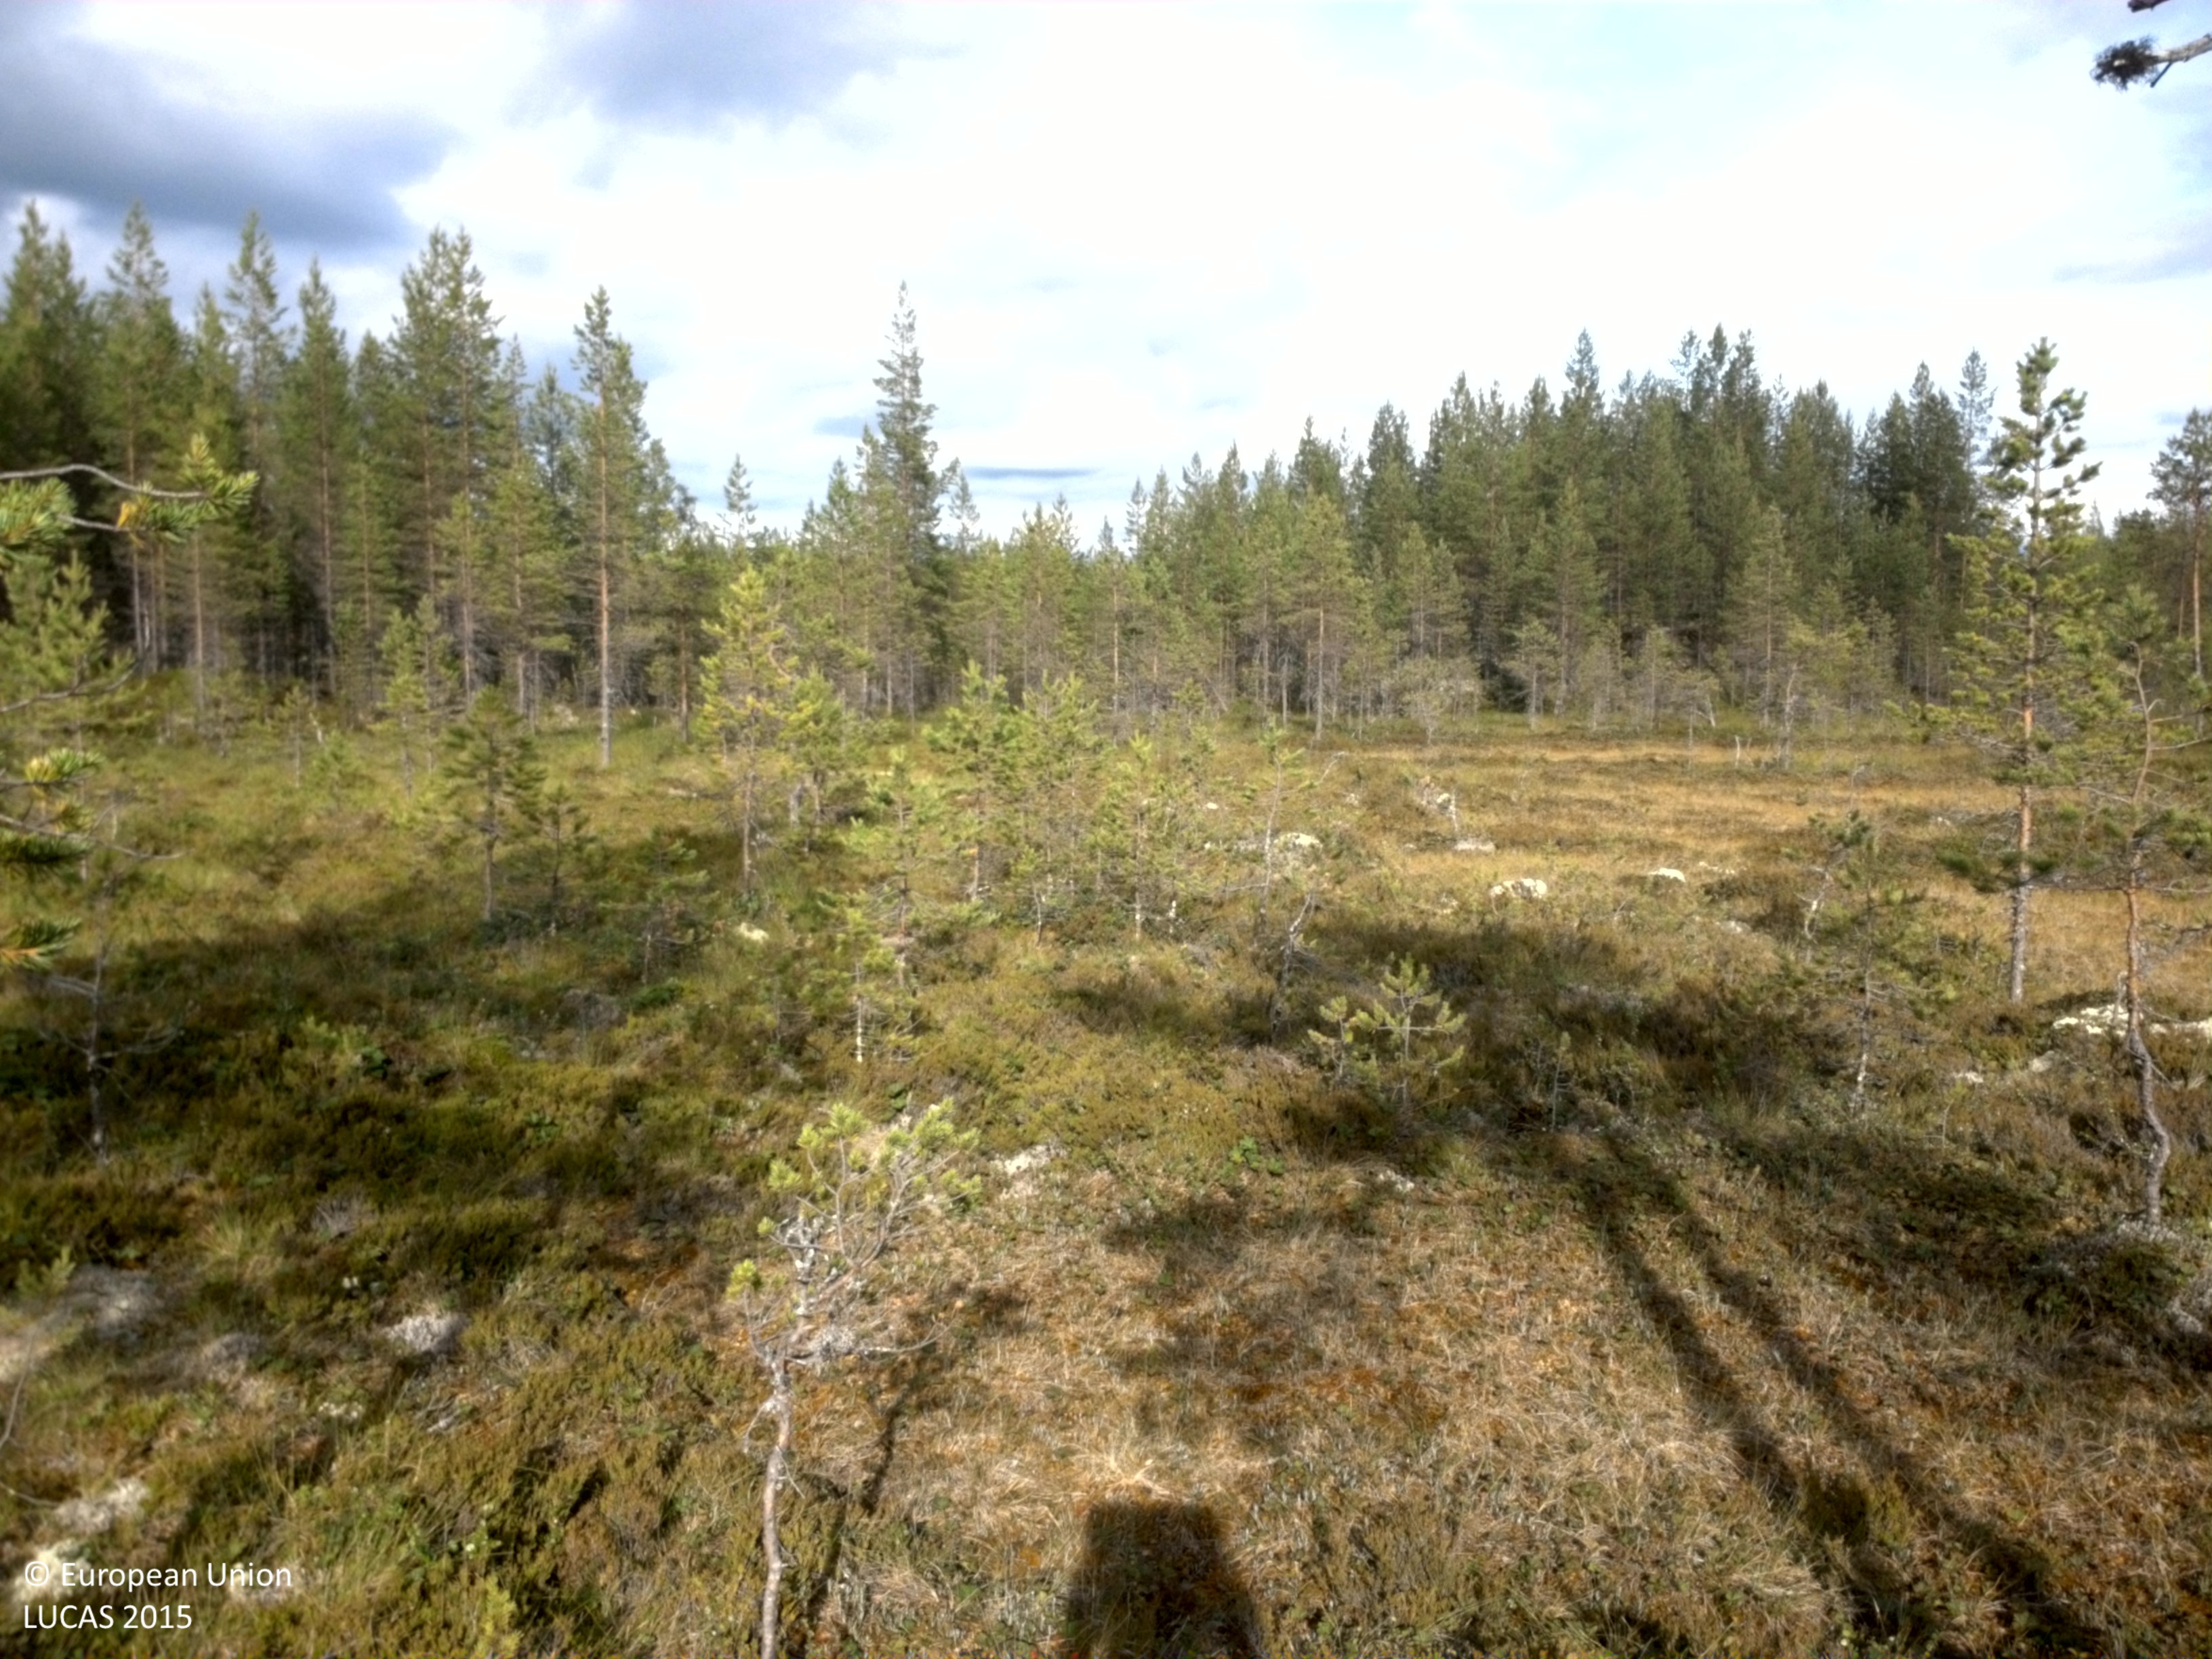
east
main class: Woodland
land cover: Pine dominated coniferous woodland
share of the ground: 10 - 25 %
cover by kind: lichens and mosses 40 %, shrubs 30 %, coniferous forest trees 20 %, herbaceous plants 10 %
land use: Semi-natural and natural areas not in use
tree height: < 5 m
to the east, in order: Pine dominated coniferous woodland; Inland fresh water bodies; Pine dominated coniferous woodland; Pine dominated mixed woodland
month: July
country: SE
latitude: 61.3256
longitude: 13.5559
